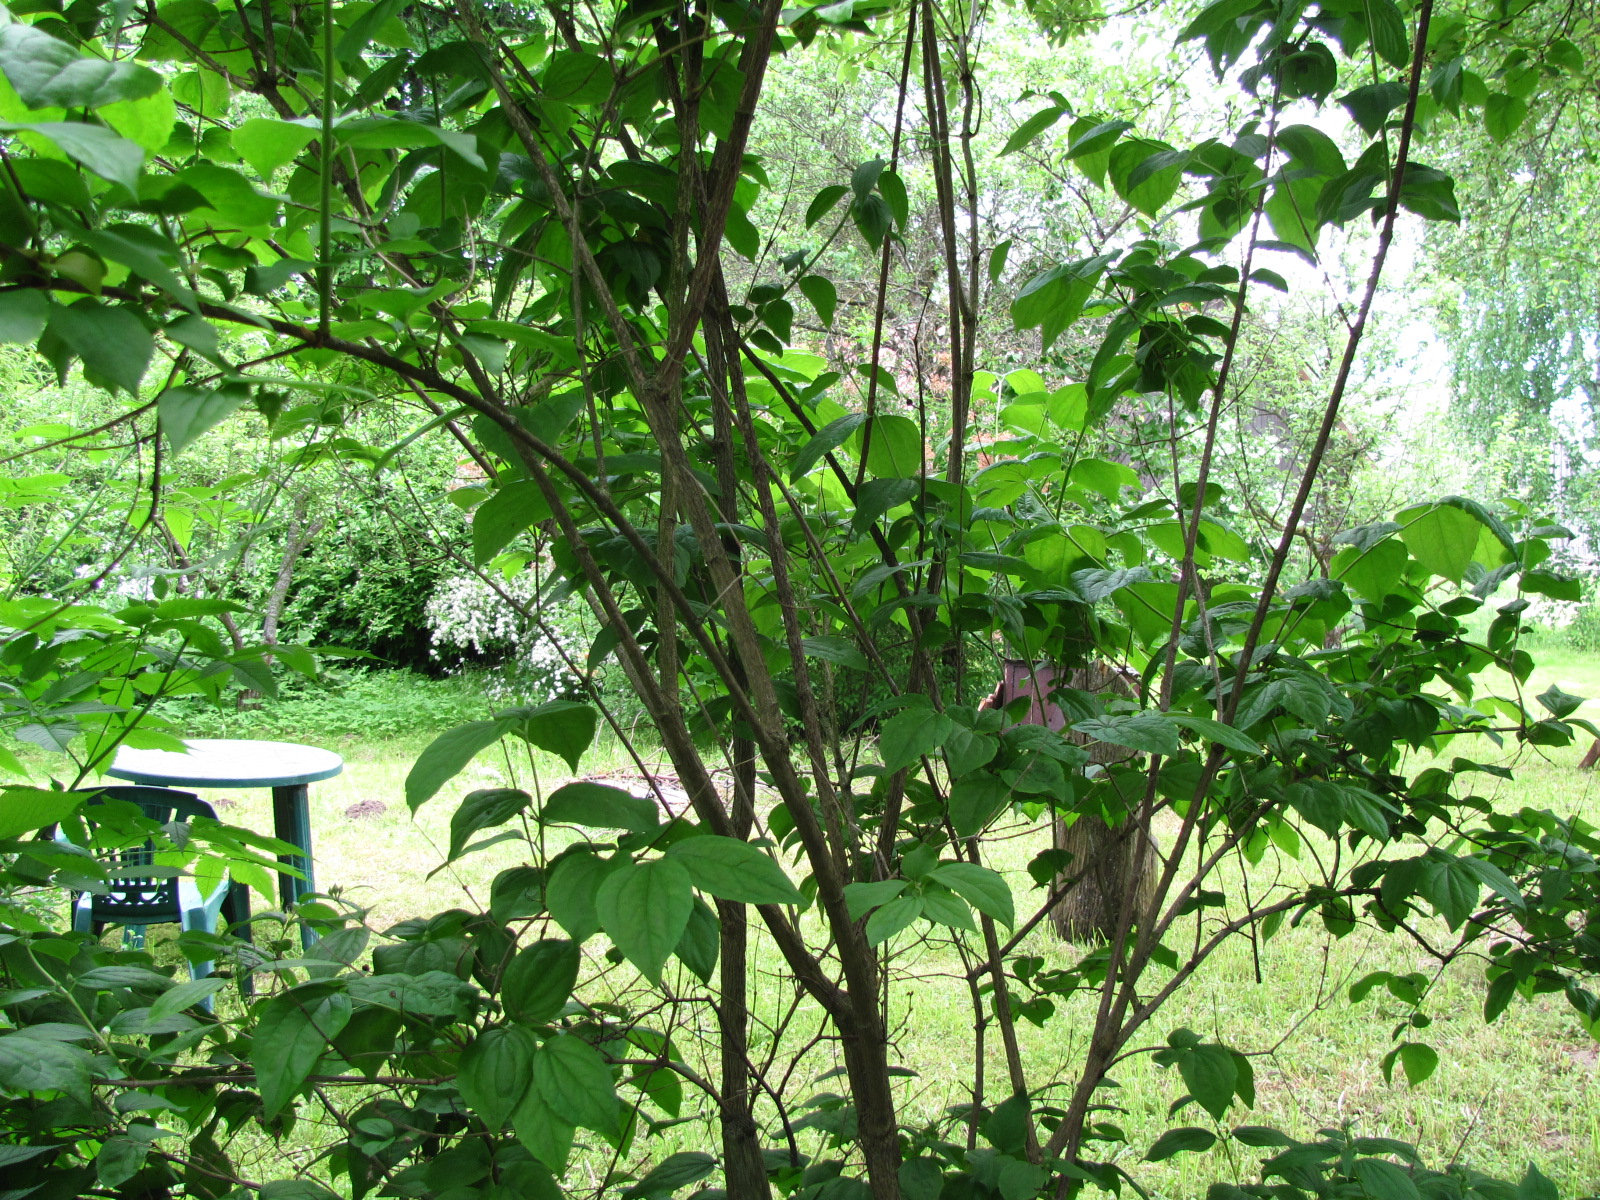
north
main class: Woodland
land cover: Broadleaved woodland
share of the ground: > 75 %
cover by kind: broadleaved forest trees 80 %, herbaceous plants 20 %
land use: Residential
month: June
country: LV
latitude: 56.3562
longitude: 24.0868
